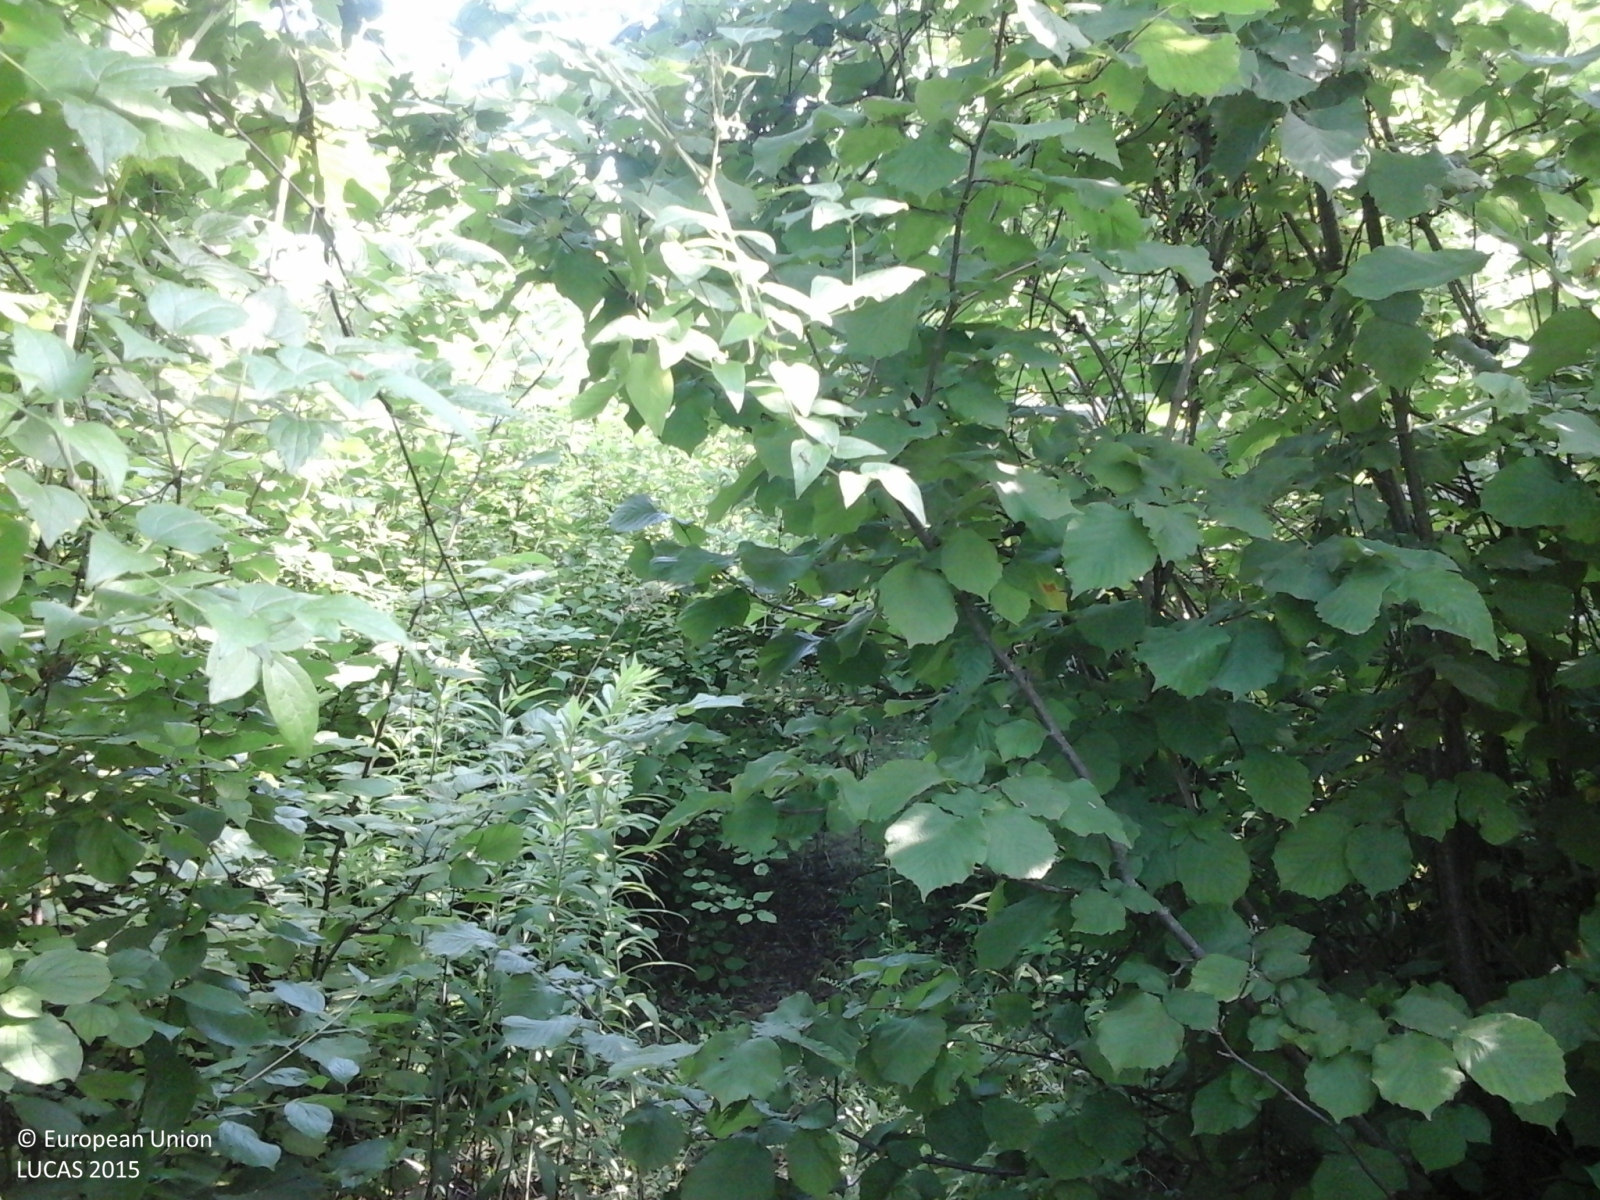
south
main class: Cropland
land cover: Nuts trees
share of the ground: > 75 %
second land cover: Spontaneously vegetated surfaces
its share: > 75 %
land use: Agriculture (excluding fallow land and kitchen gardens)
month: June
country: IT
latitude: 44.9849
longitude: 8.2404
